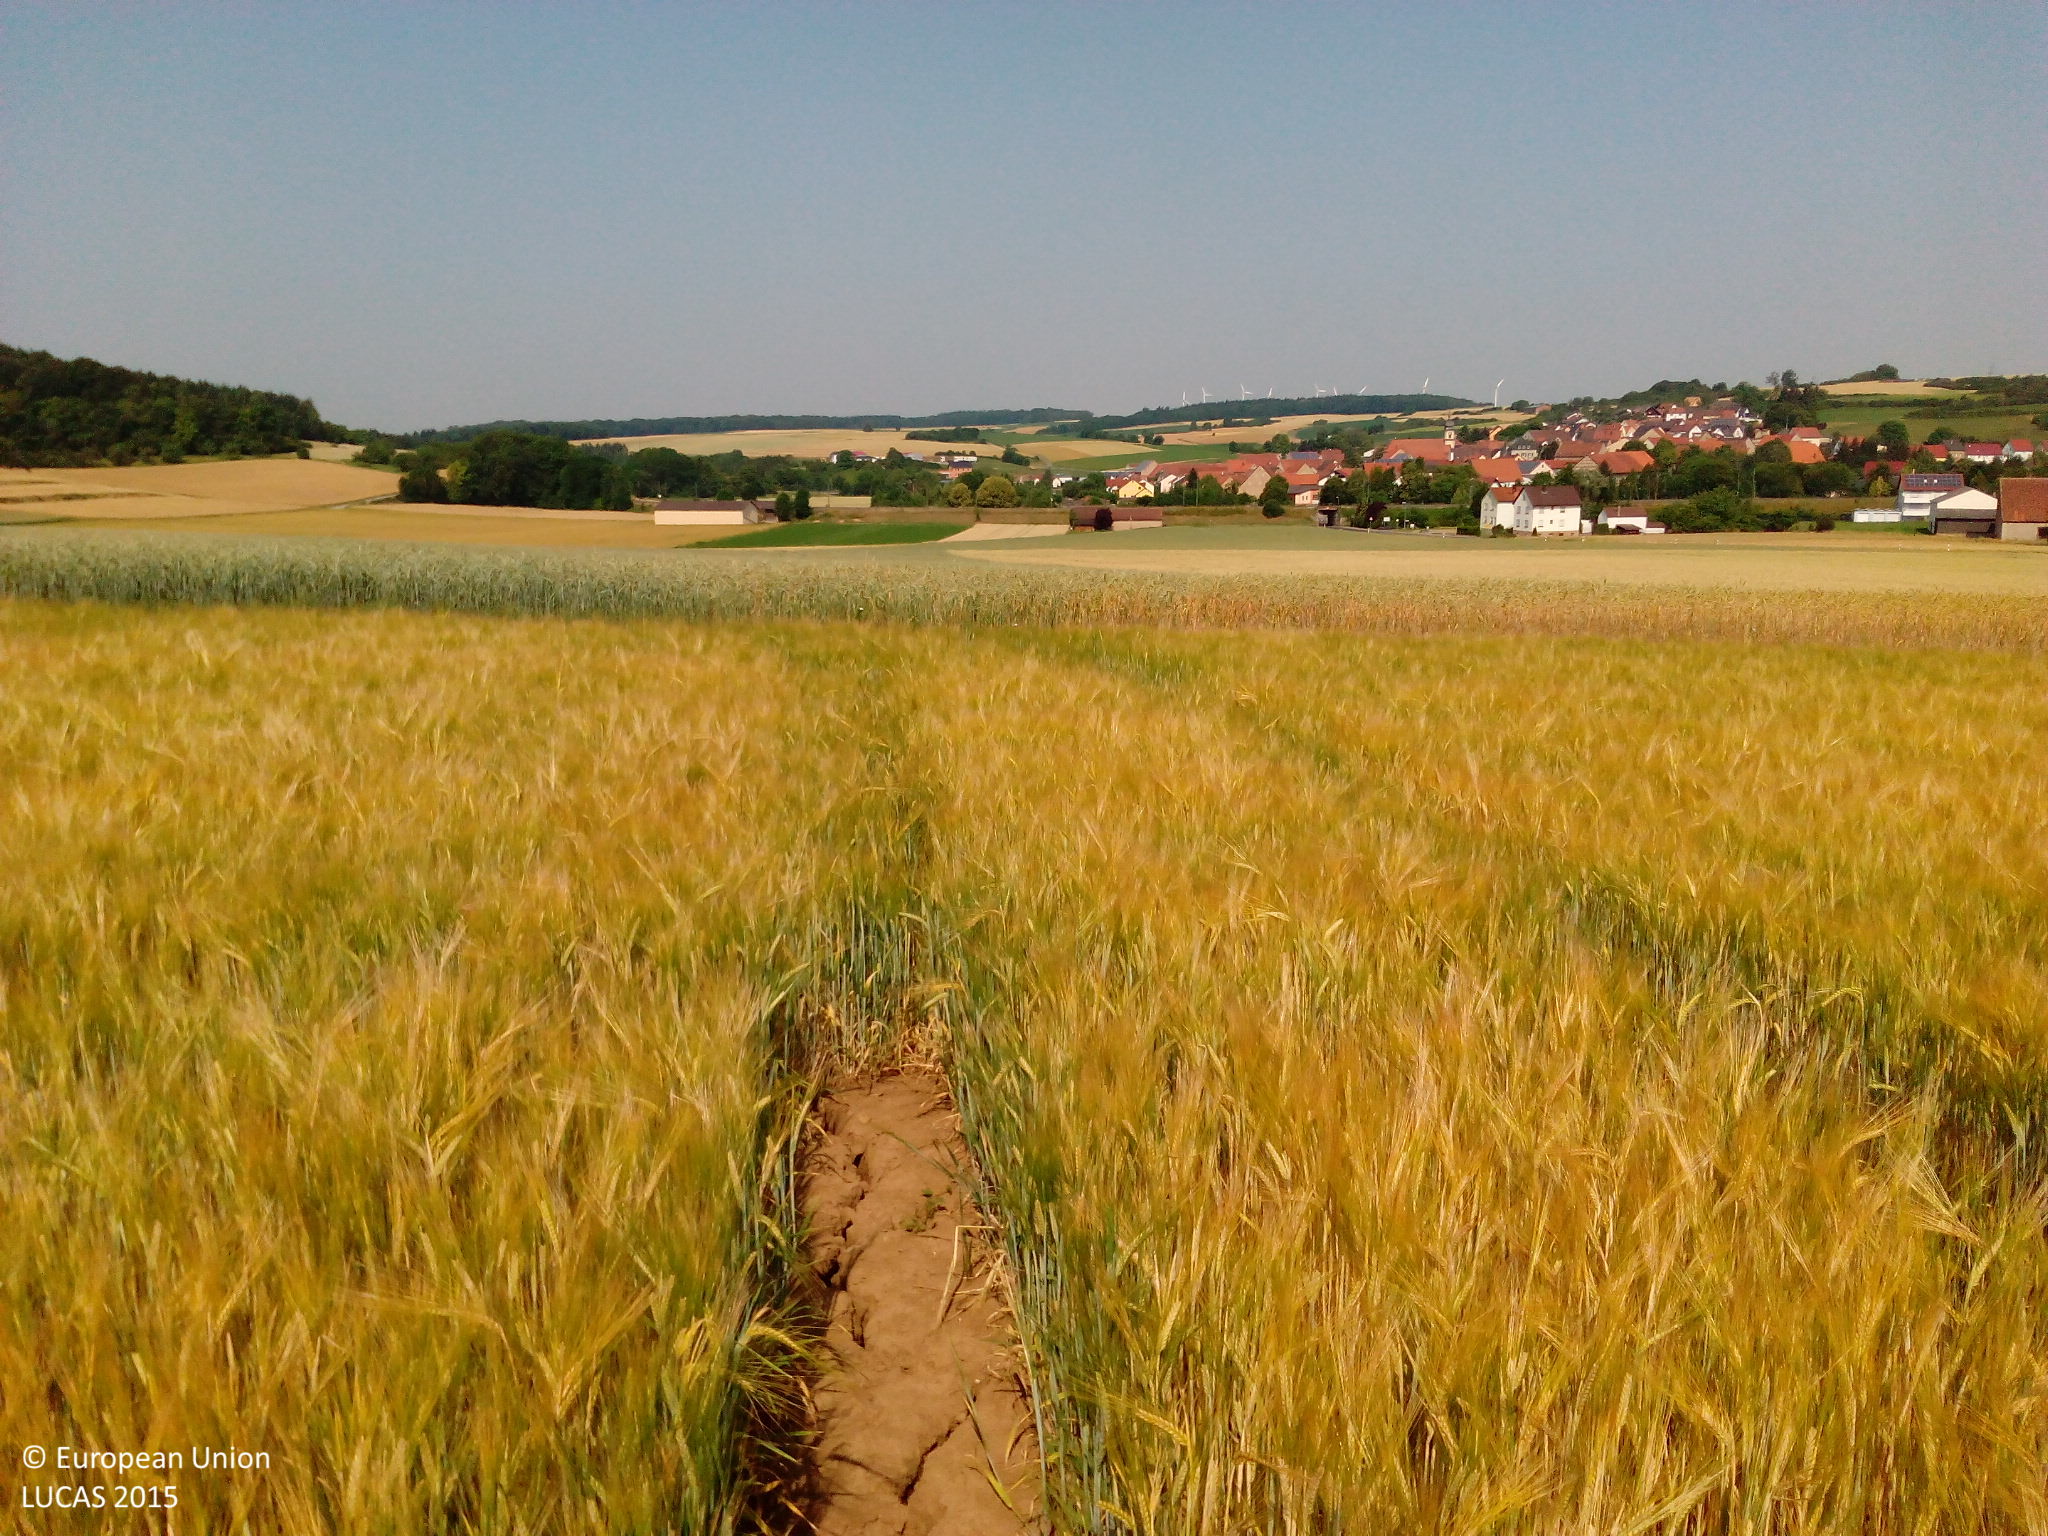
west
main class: Cropland
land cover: Barley
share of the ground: > 75 %
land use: Agriculture (excluding fallow land and kitchen gardens)
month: July
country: DE
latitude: 49.6086
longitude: 9.8478
